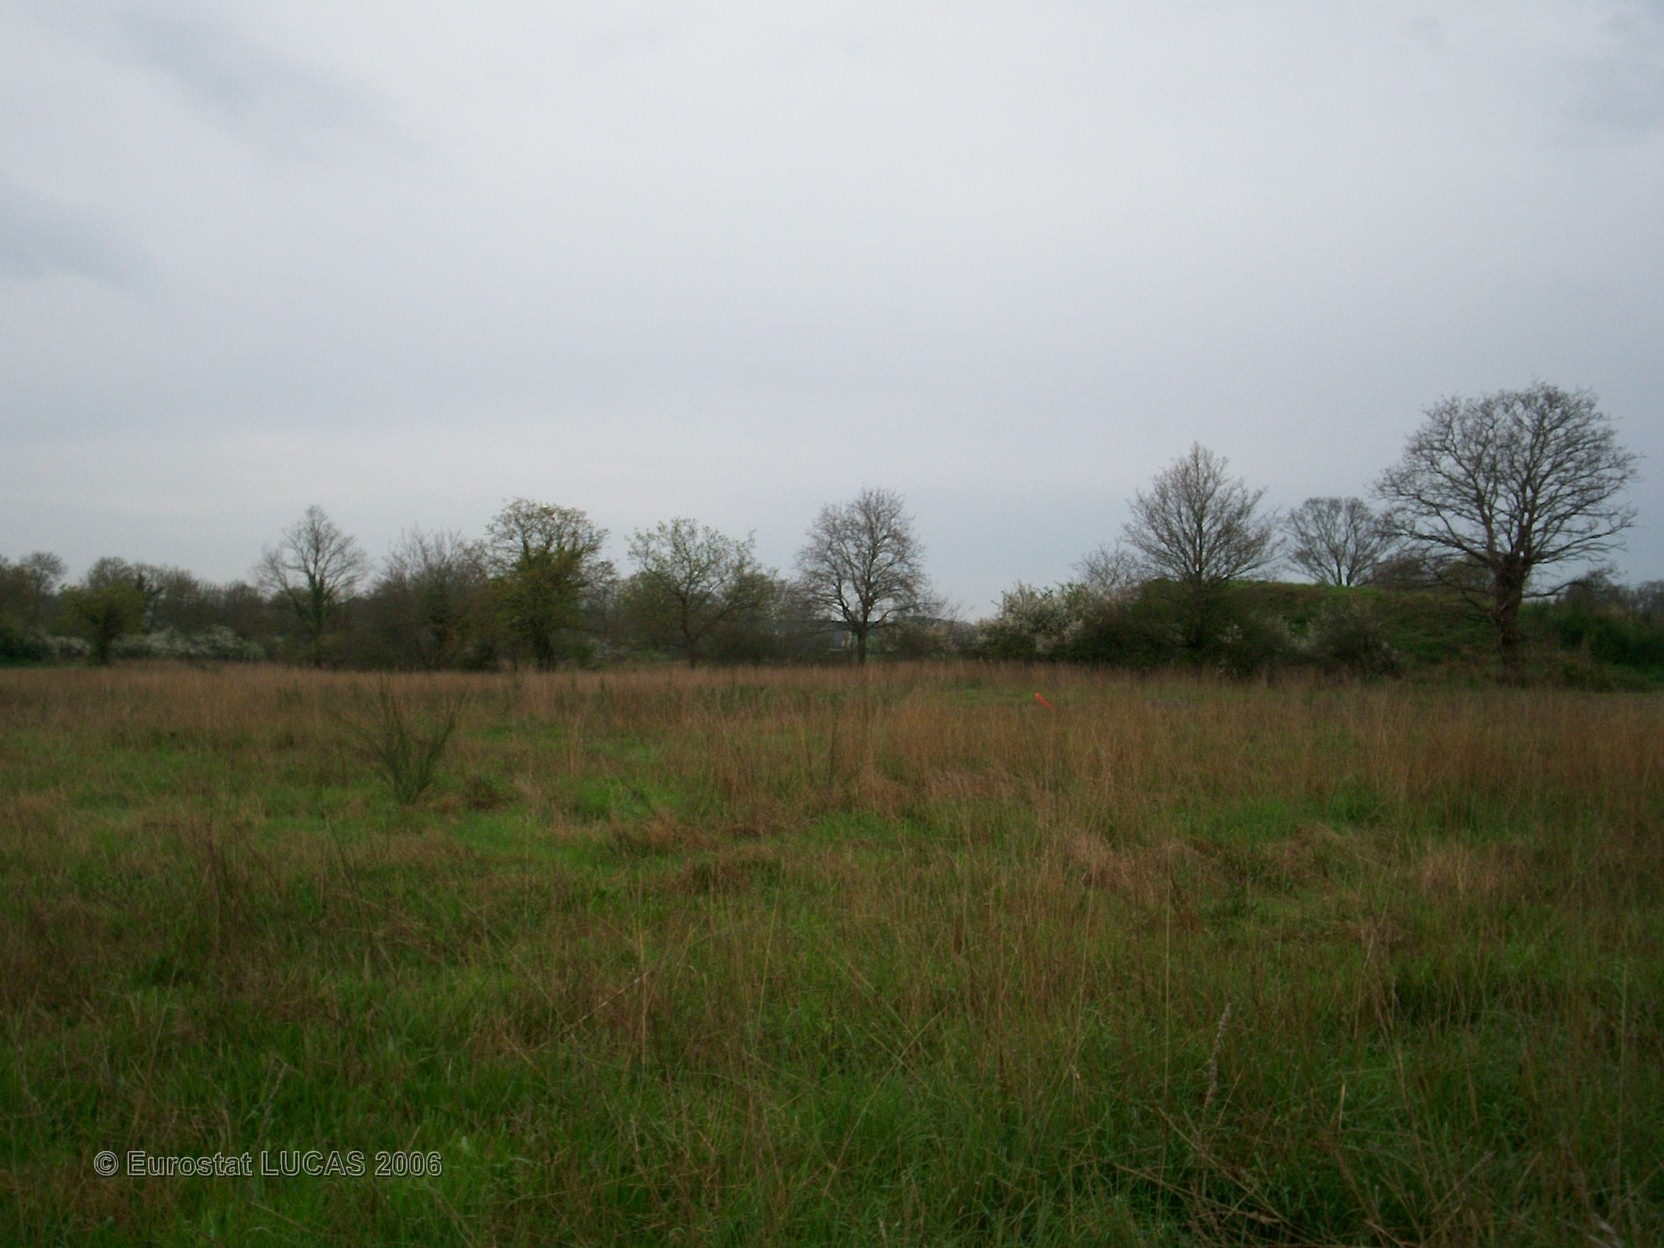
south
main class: Grassland
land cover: Grassland without tree/shrub cover
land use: Agriculture (excluding fallow land and kitchen gardens)
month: April
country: FR
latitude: 47.6438
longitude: -2.7475
